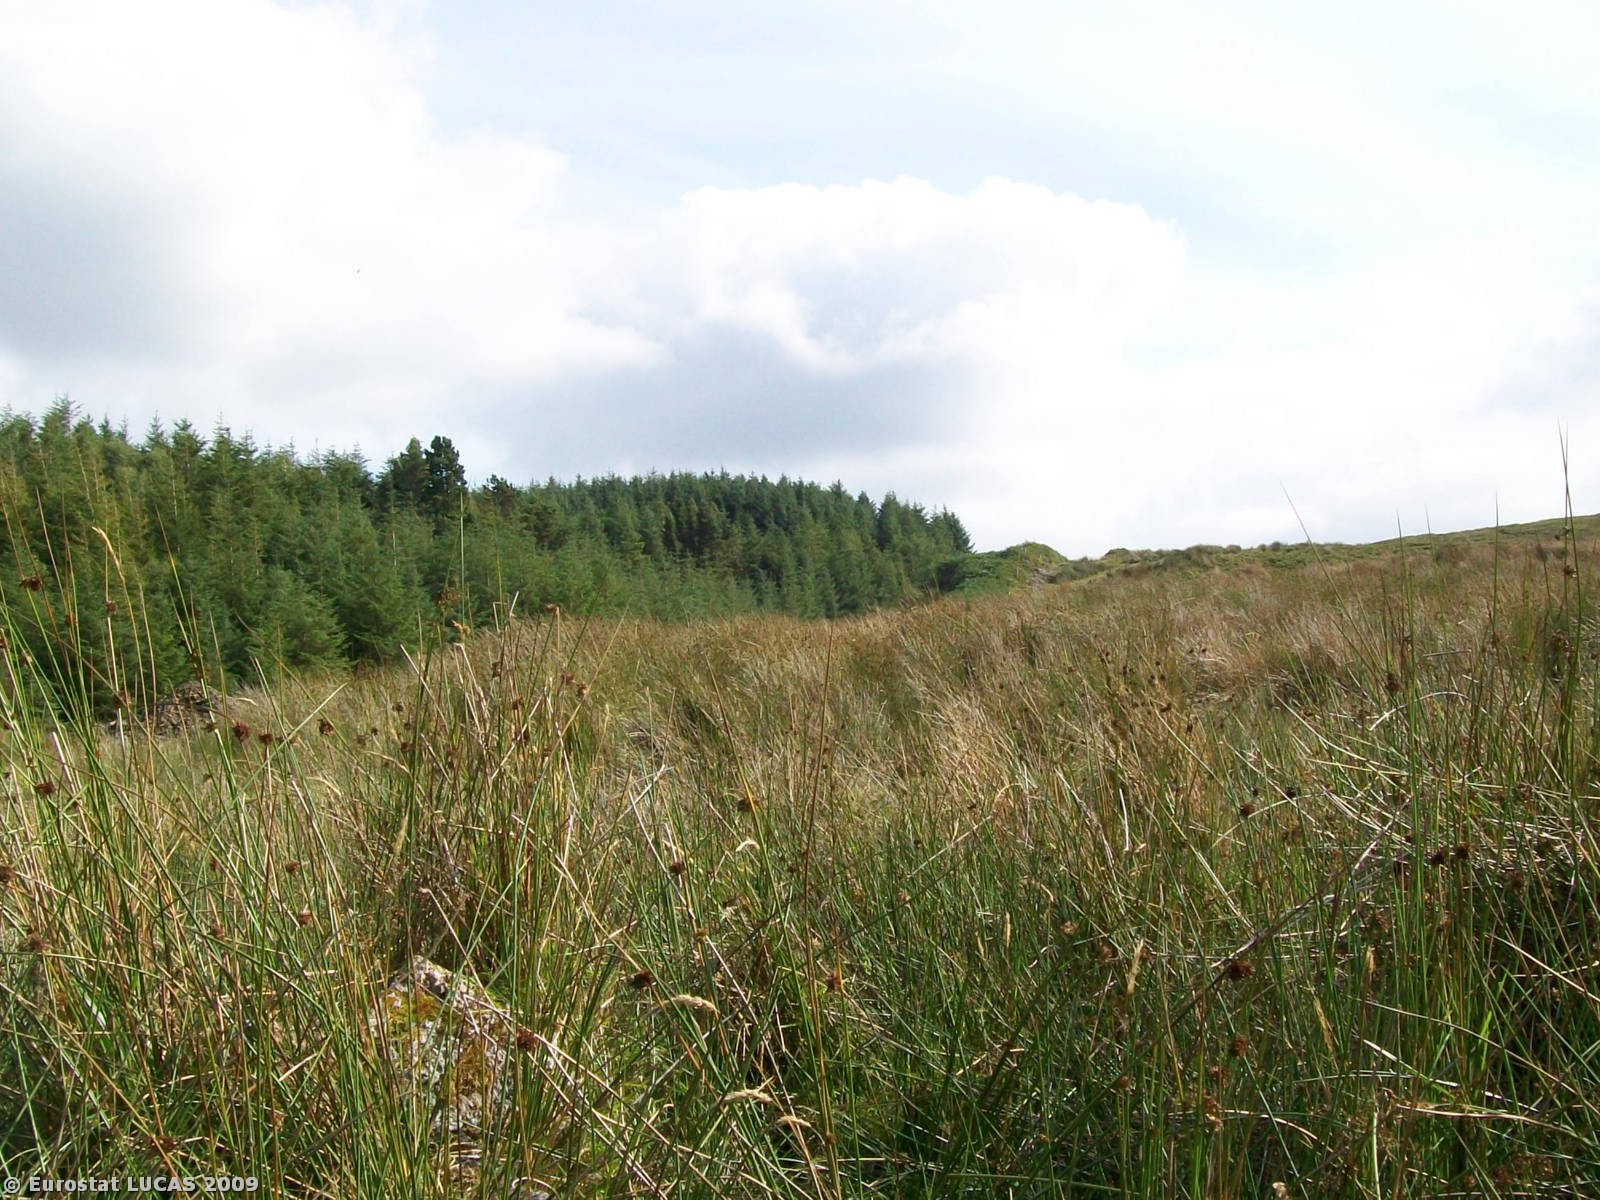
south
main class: Woodland
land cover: Coniferous woodland
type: plantations and self-sown exotic forest
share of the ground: > 75 %
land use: Forestry
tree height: > 5 m
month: August
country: IE
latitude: 52.7899
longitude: -9.1861
